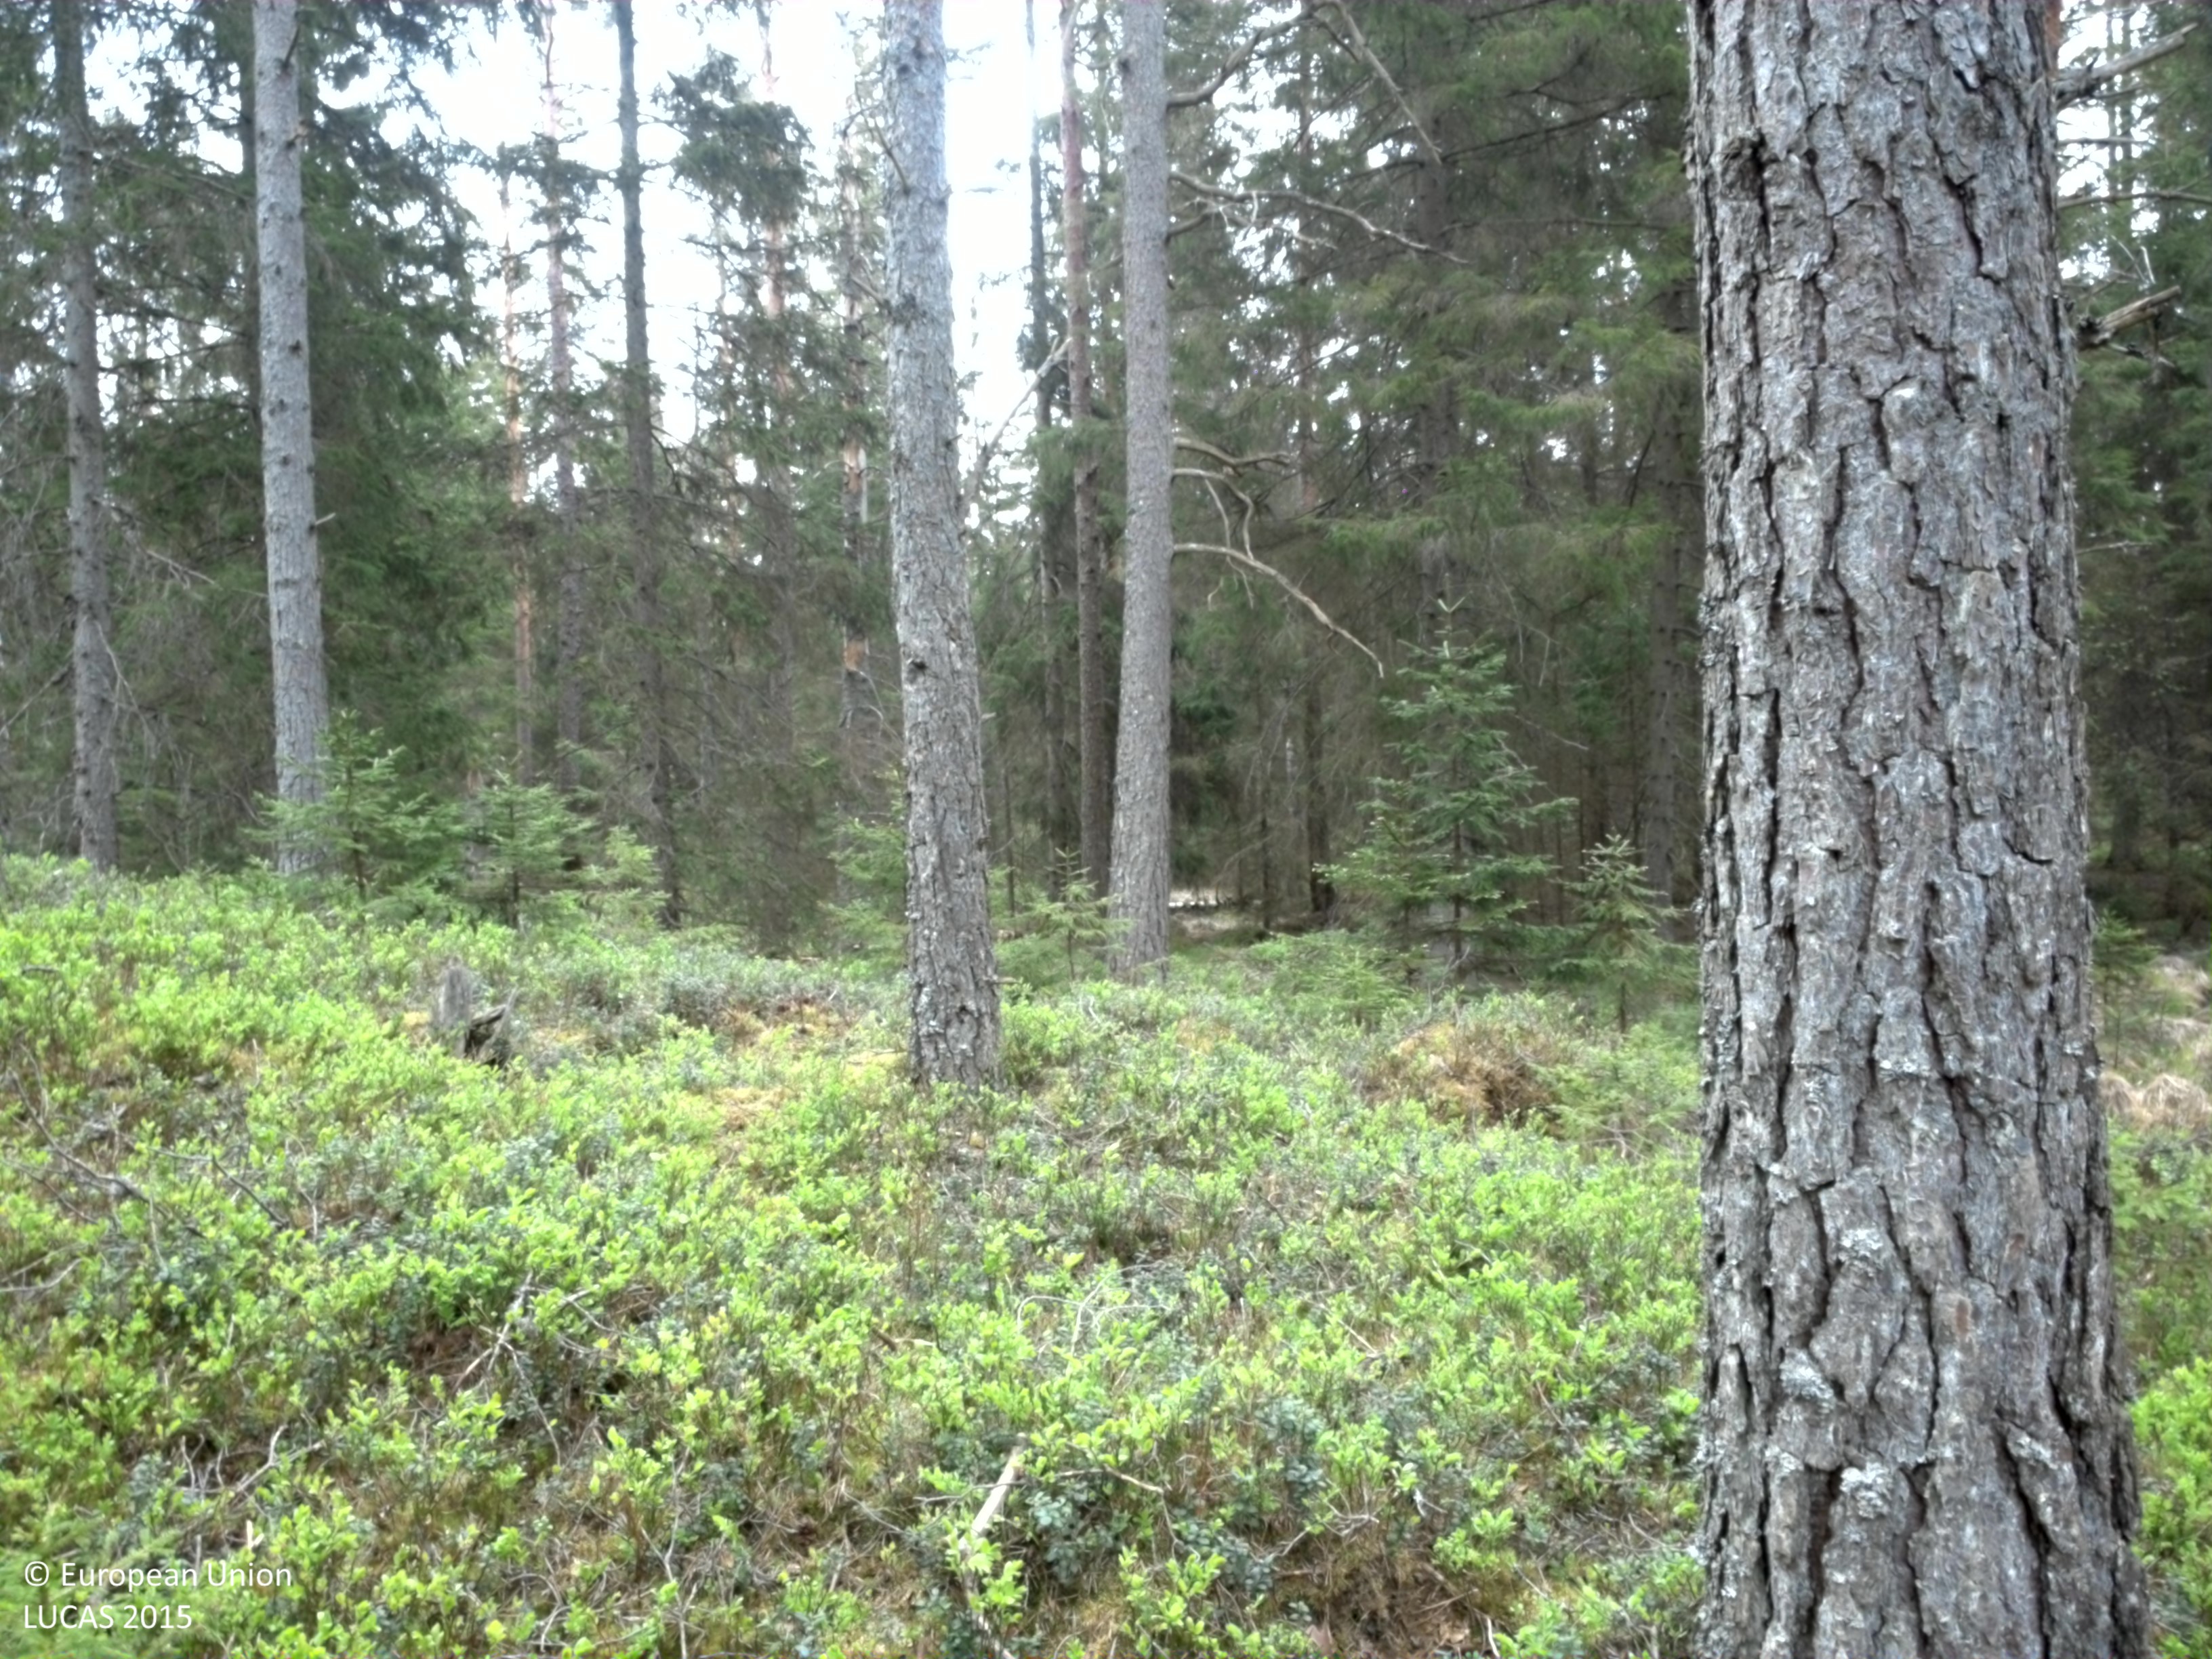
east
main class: Woodland
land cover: Pine dominated coniferous woodland
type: boreal forest
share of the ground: 50 - 75 %
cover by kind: coniferous forest trees 70 %, shrubs 15 %, lichens and mosses 15 %
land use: Forestry
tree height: > 5 m
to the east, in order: Pine dominated coniferous woodland; Spruce dominated coniferous woodland; Ditches and canals; Spruce dominated coniferous woodland; Pine dominated coniferous woodland; Pine dominated mixed woodland
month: May
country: SE
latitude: 56.8766
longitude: 15.1663
